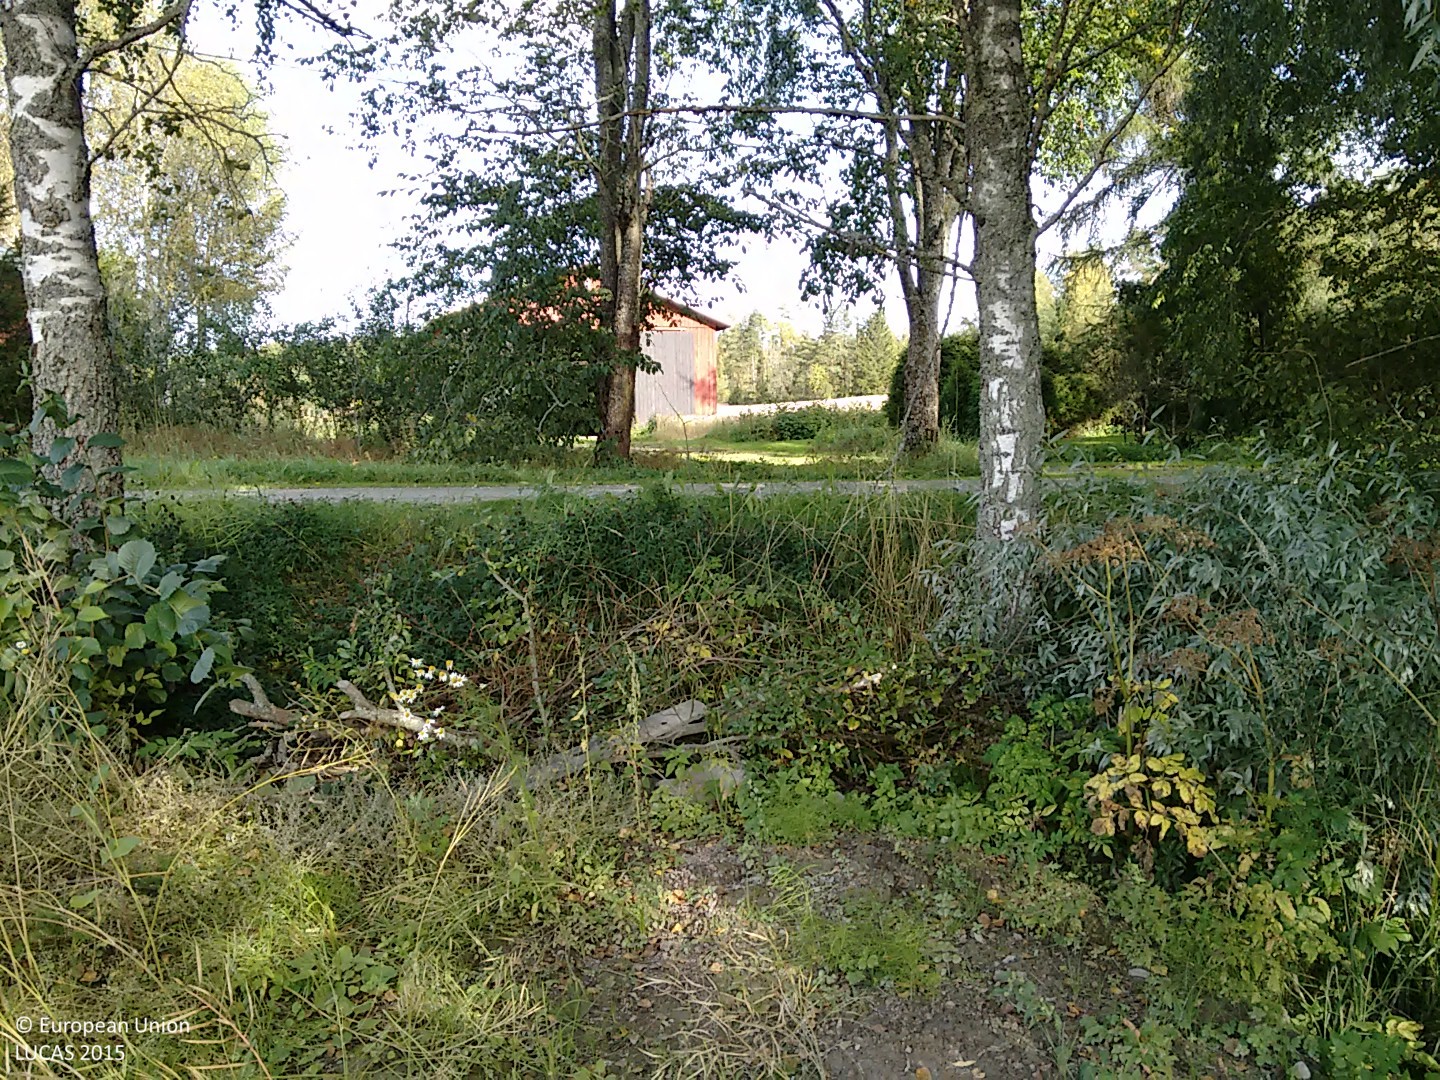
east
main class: Cropland
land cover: Rape and turnip rape
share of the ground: > 75 %
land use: Agriculture (excluding fallow land and kitchen gardens)
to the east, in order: Rape and turnip rape; Shruby margins; Broadleaved woodland; Rivers and streams; Broadleaved woodland; Paved roads, cycling and walking lanes; Broadleaved woodland; Electric lines; Conifer hedges; Common wheat; Clovers; Common wheat
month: September
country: FI
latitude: 60.8048
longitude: 21.6906
